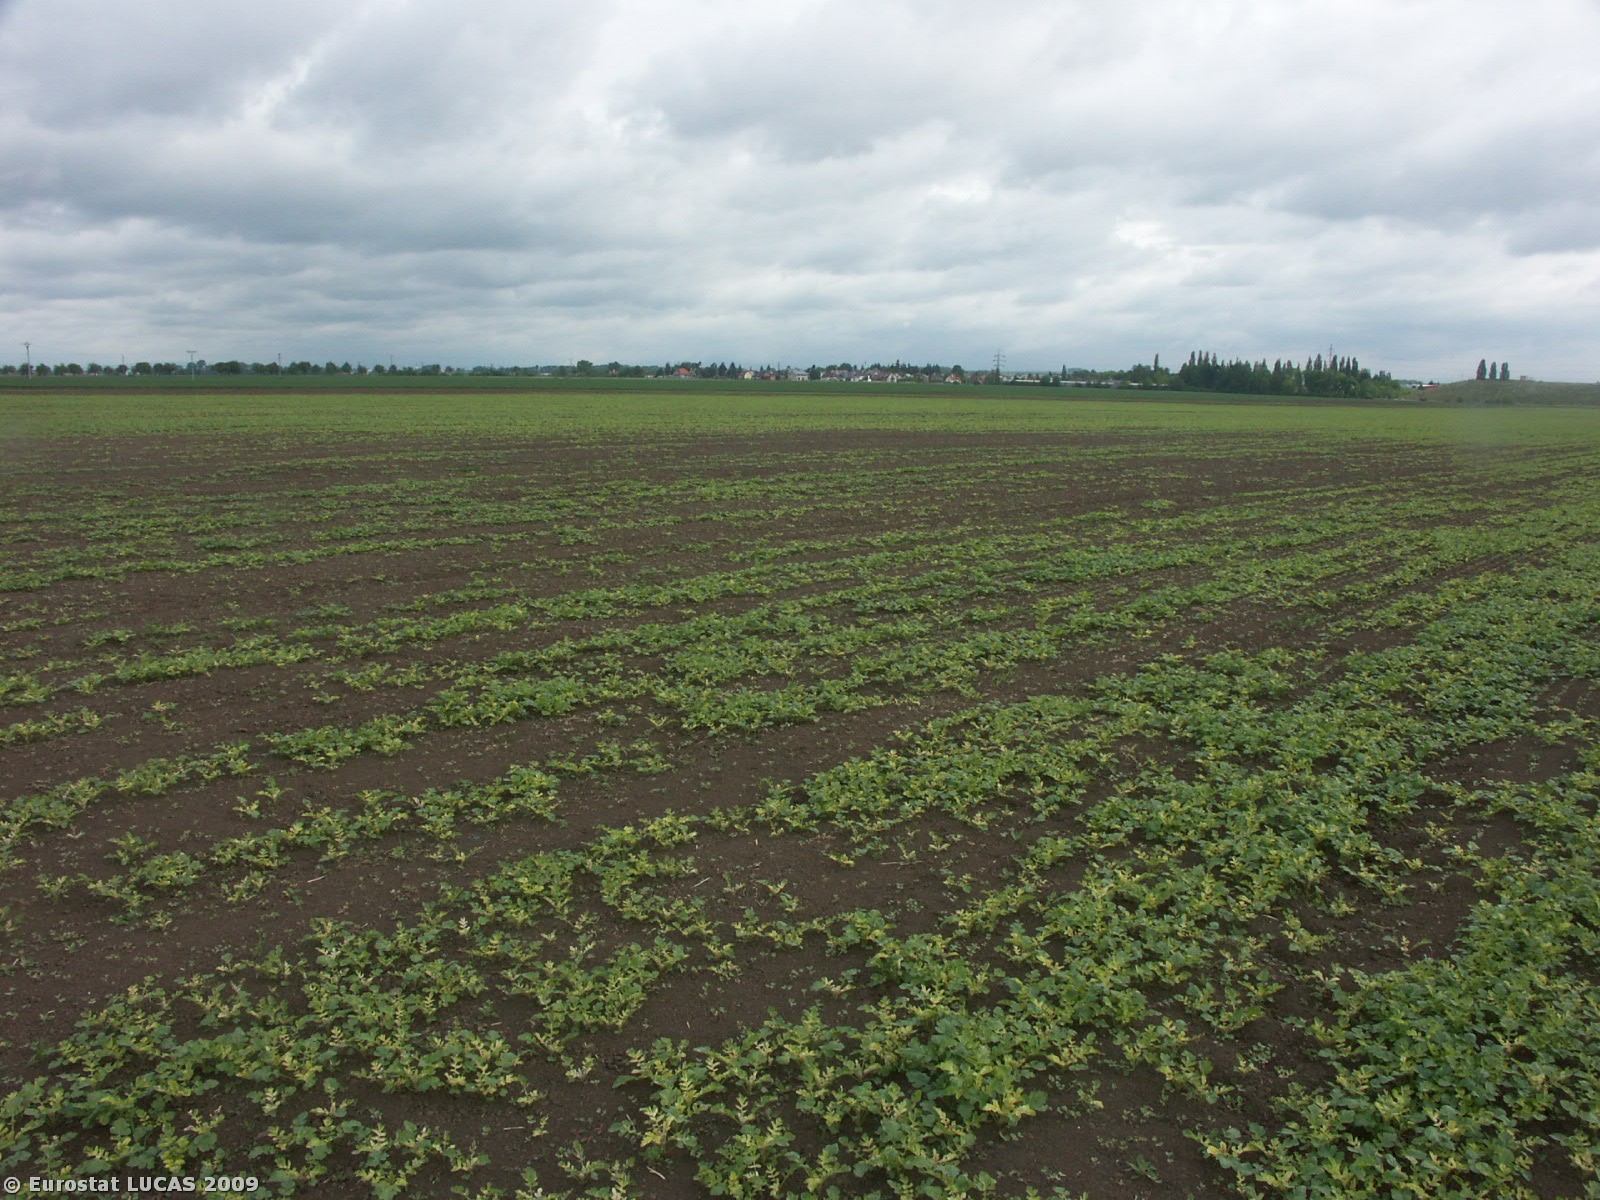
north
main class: Cropland
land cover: Other fibre and oleaginous crops
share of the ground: 50 - 75 %
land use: Agriculture (excluding fallow land and kitchen gardens)
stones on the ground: < 10 %
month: May
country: CZ
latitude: 49.5458
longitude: 17.1279
